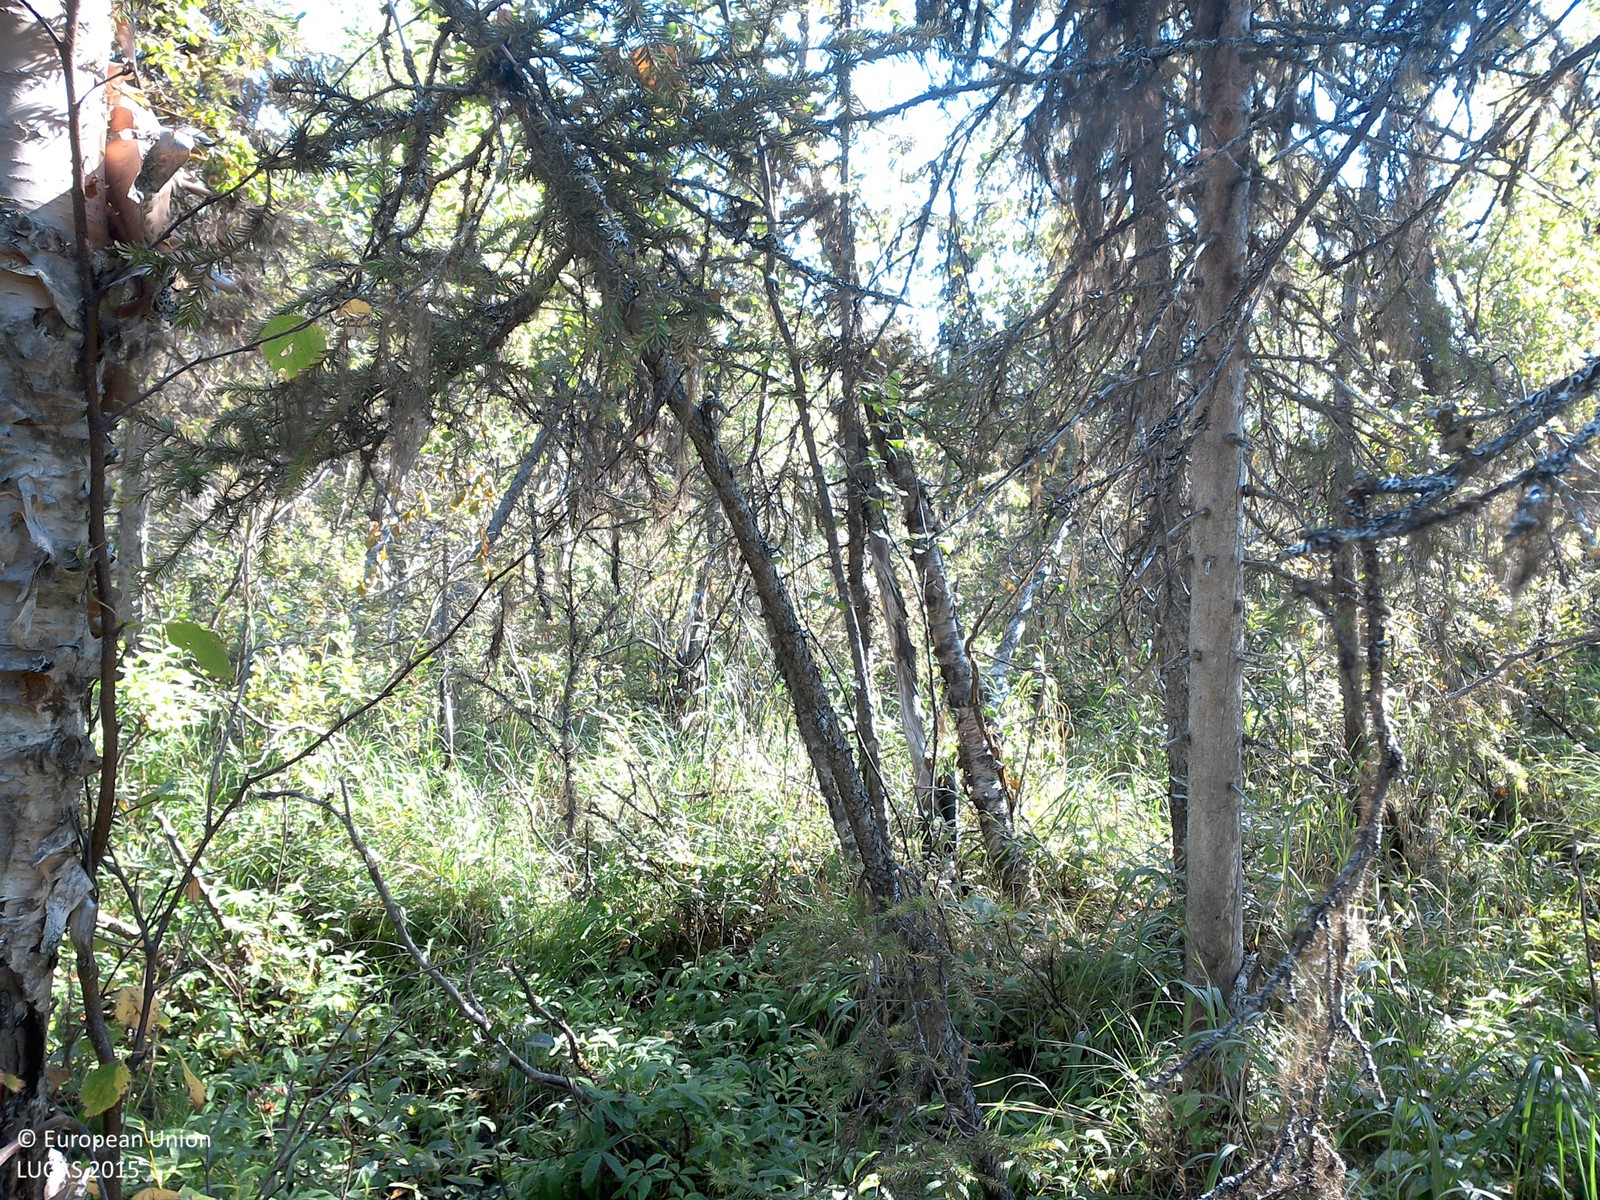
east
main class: Woodland
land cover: Spruce dominated mixed woodland
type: boreal forest
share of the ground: 25 - 50 %
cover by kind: shrubs 40 %, coniferous forest trees 20 %, herbaceous plants 20 %, broadleaved forest trees 15 %, lichens and mosses 5 %
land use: Forestry
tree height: > 5 m
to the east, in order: Spruce dominated mixed woodland; Spruce dominated coniferous woodland; Pine dominated coniferous woodland; Spruce dominated coniferous woodland; Pine dominated mixed woodland; Spruce dominated mixed woodland; Shrubland with sparse tree cover; Peatbogs
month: August
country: SE
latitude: 67.0629
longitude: 21.9387
